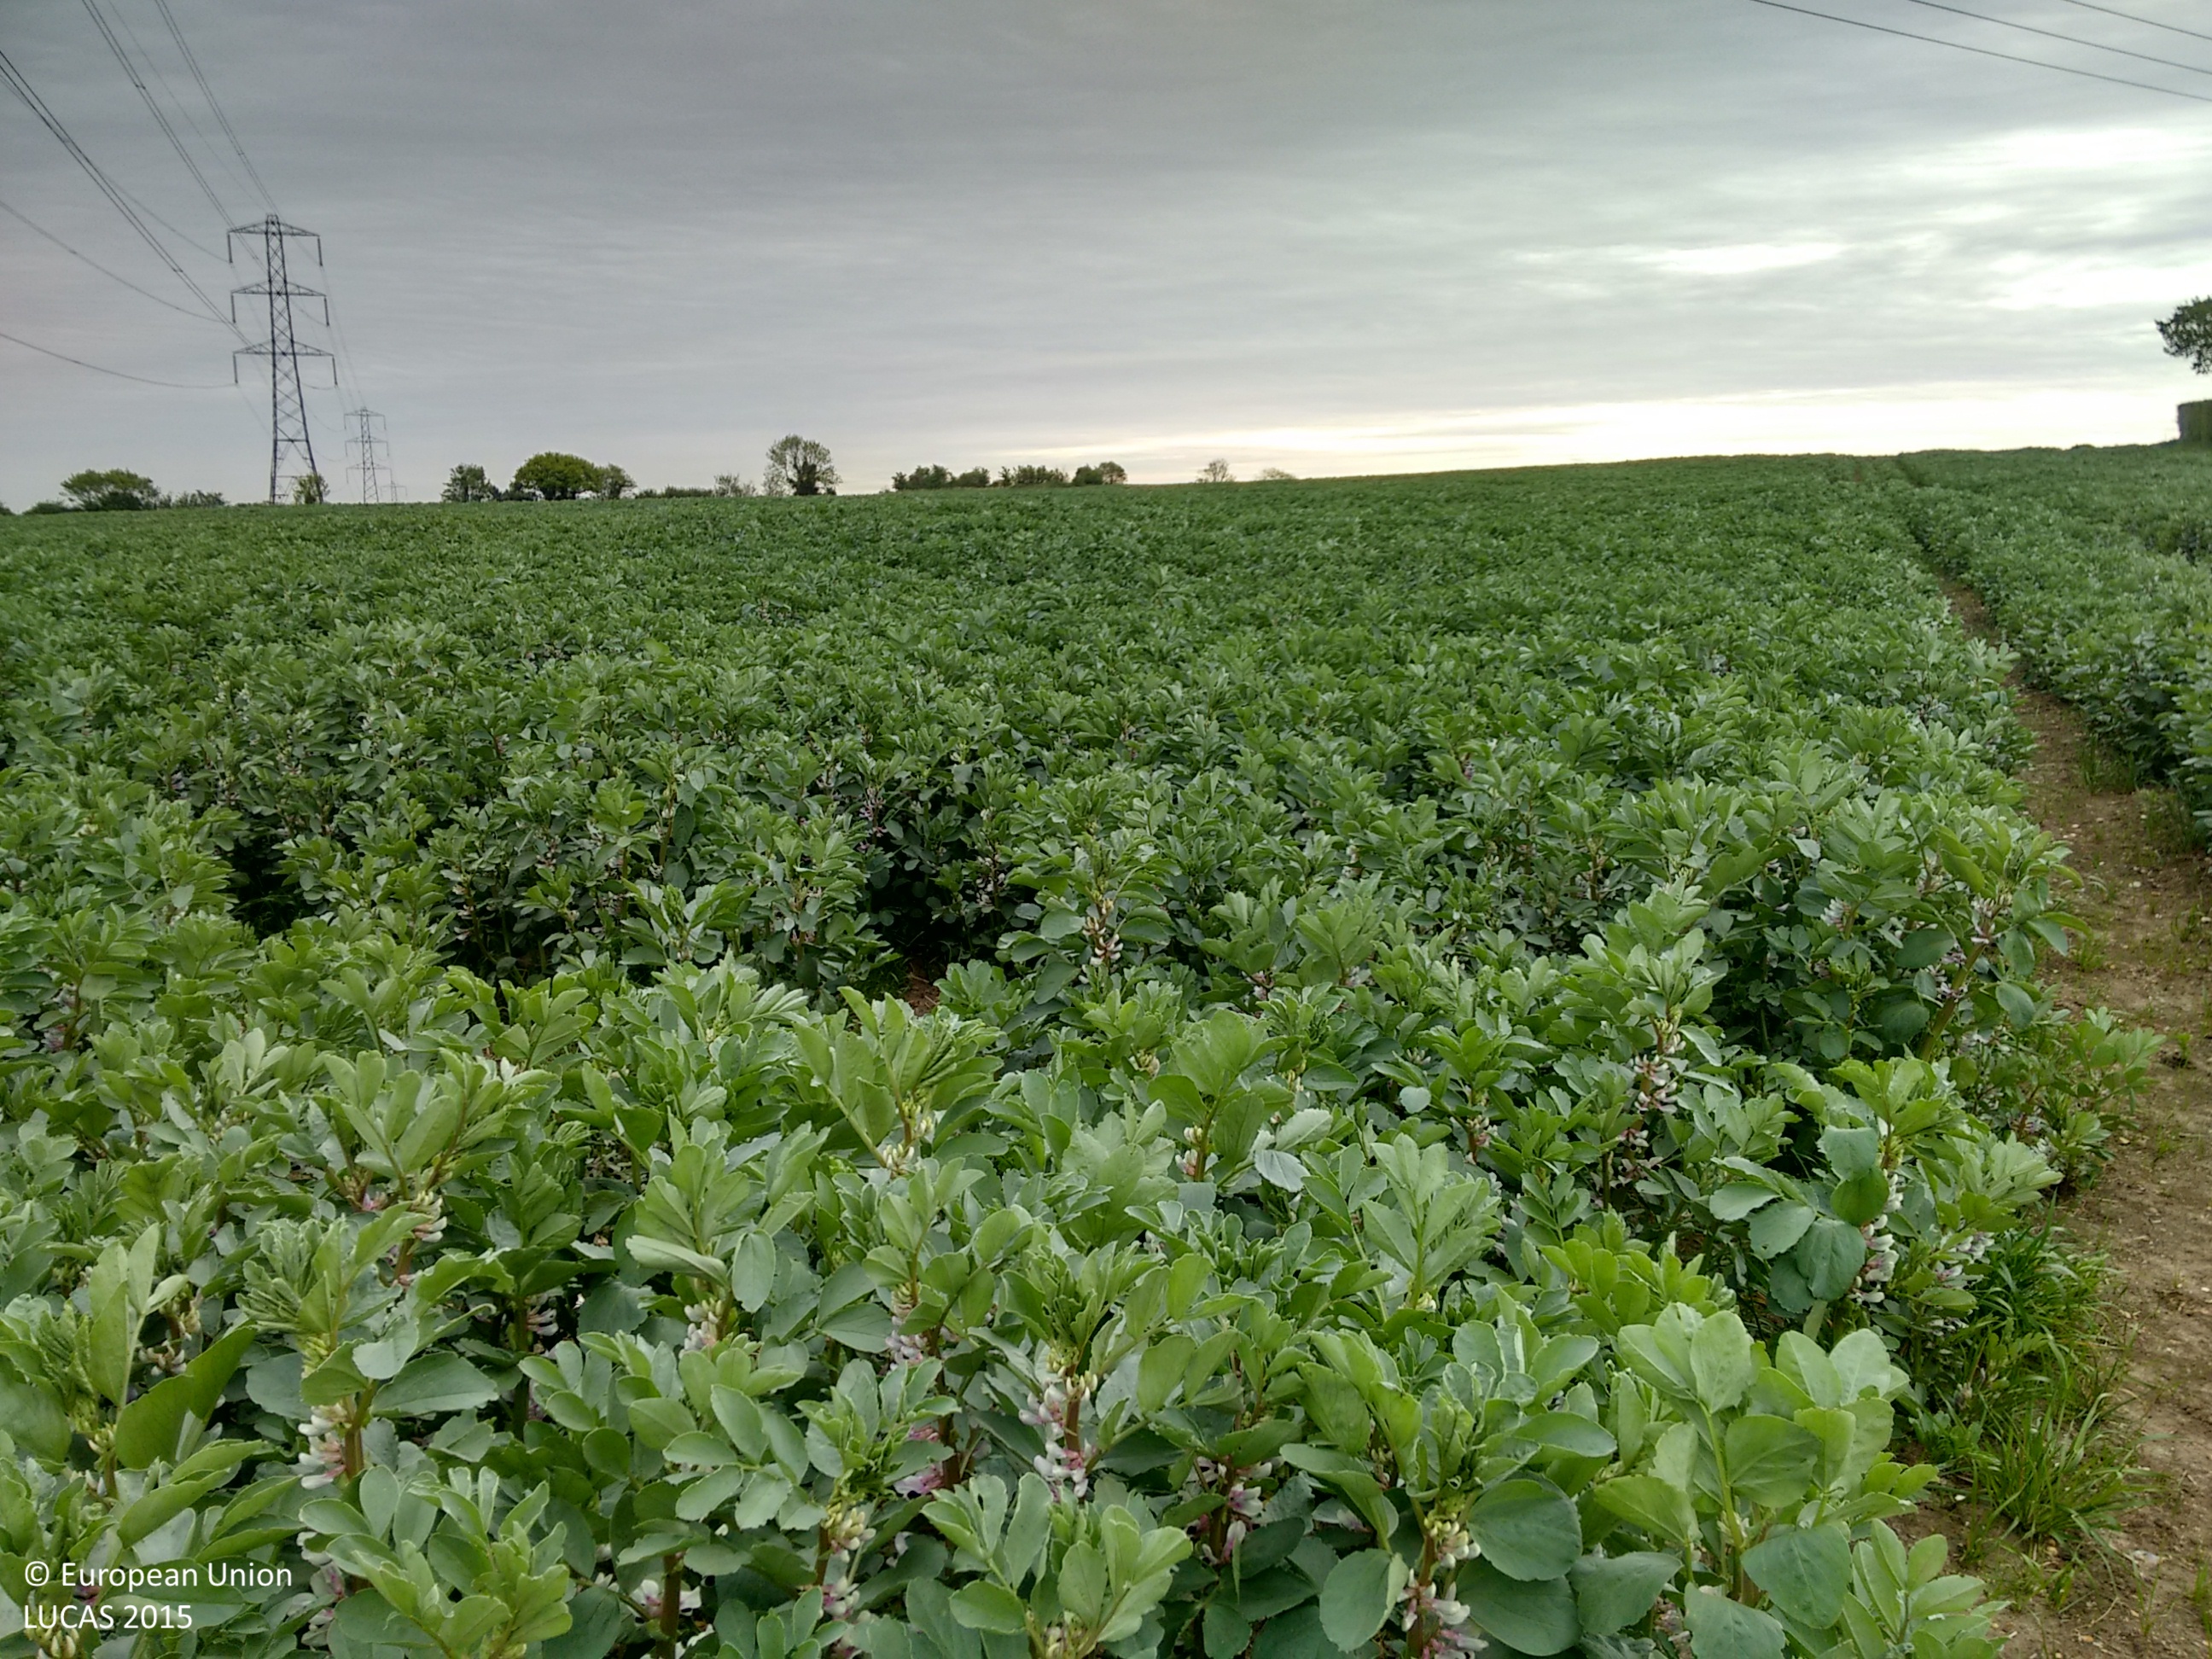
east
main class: Cropland
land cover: Dry pulses
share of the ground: > 75 %
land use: Agriculture (excluding fallow land and kitchen gardens)
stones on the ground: 10 - 25 %
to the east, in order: Dry pulses; Electric lines; Dry pulses; Electric lines; Dry pulses
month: May
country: GB
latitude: 51.3972
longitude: 0.2680
